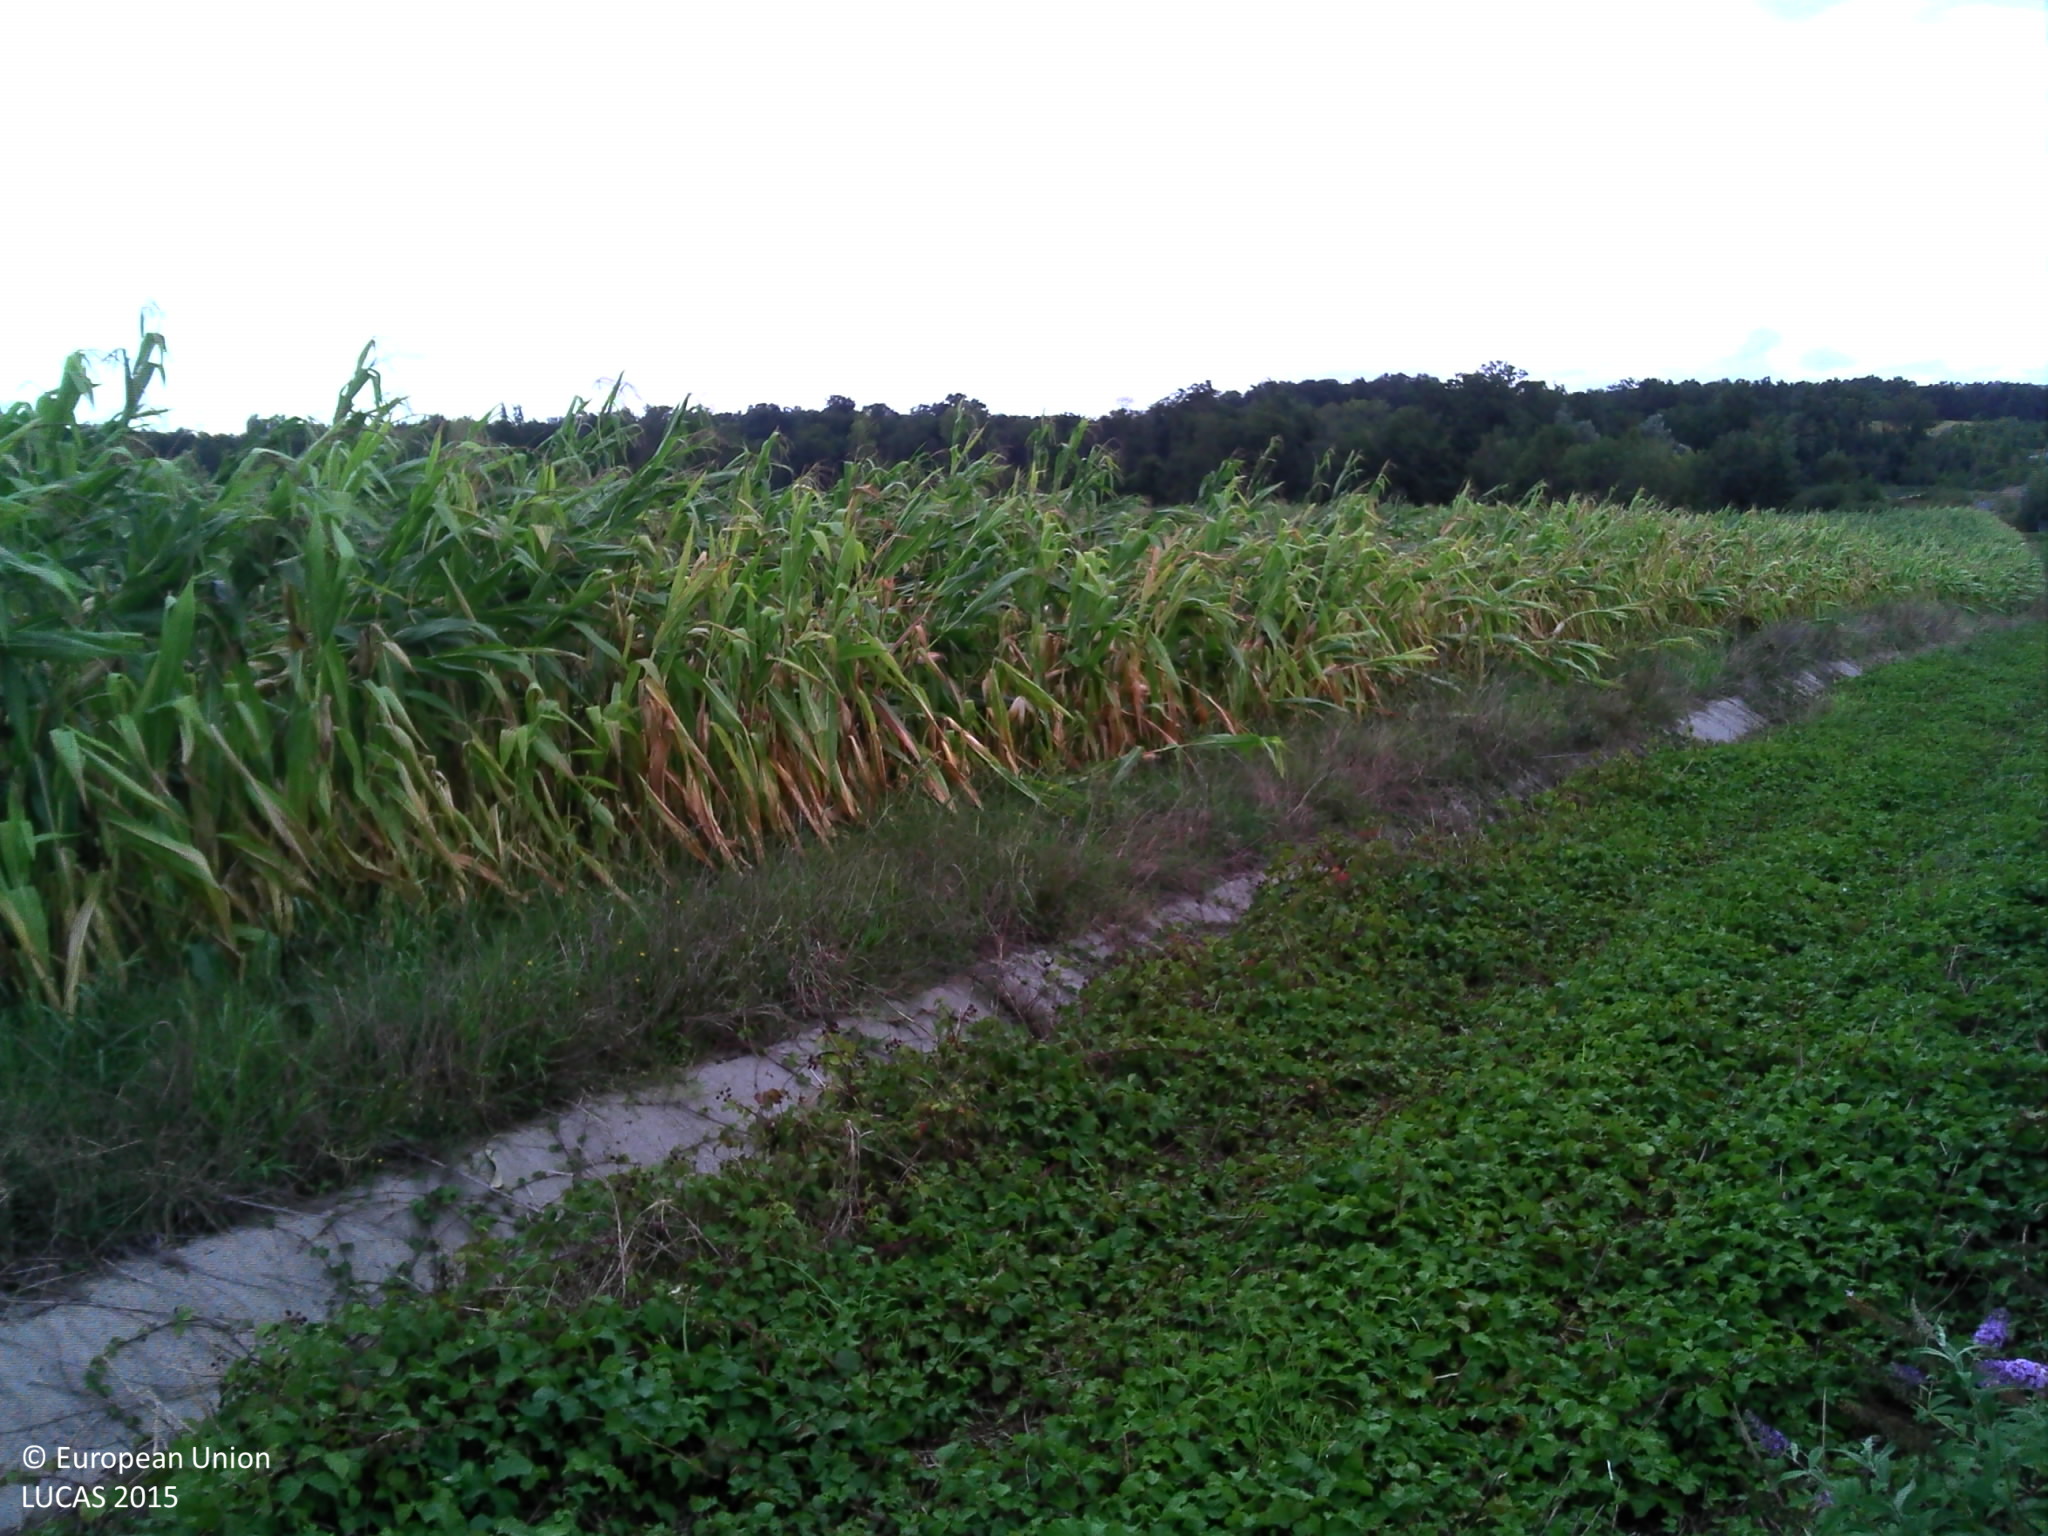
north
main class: Grassland
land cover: Grassland without tree/shrub cover
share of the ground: > 75 %
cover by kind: herbaceous plants 95 %, shrubs 5 %
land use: Road transport
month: September
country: FR
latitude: 43.4221
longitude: -0.4453
